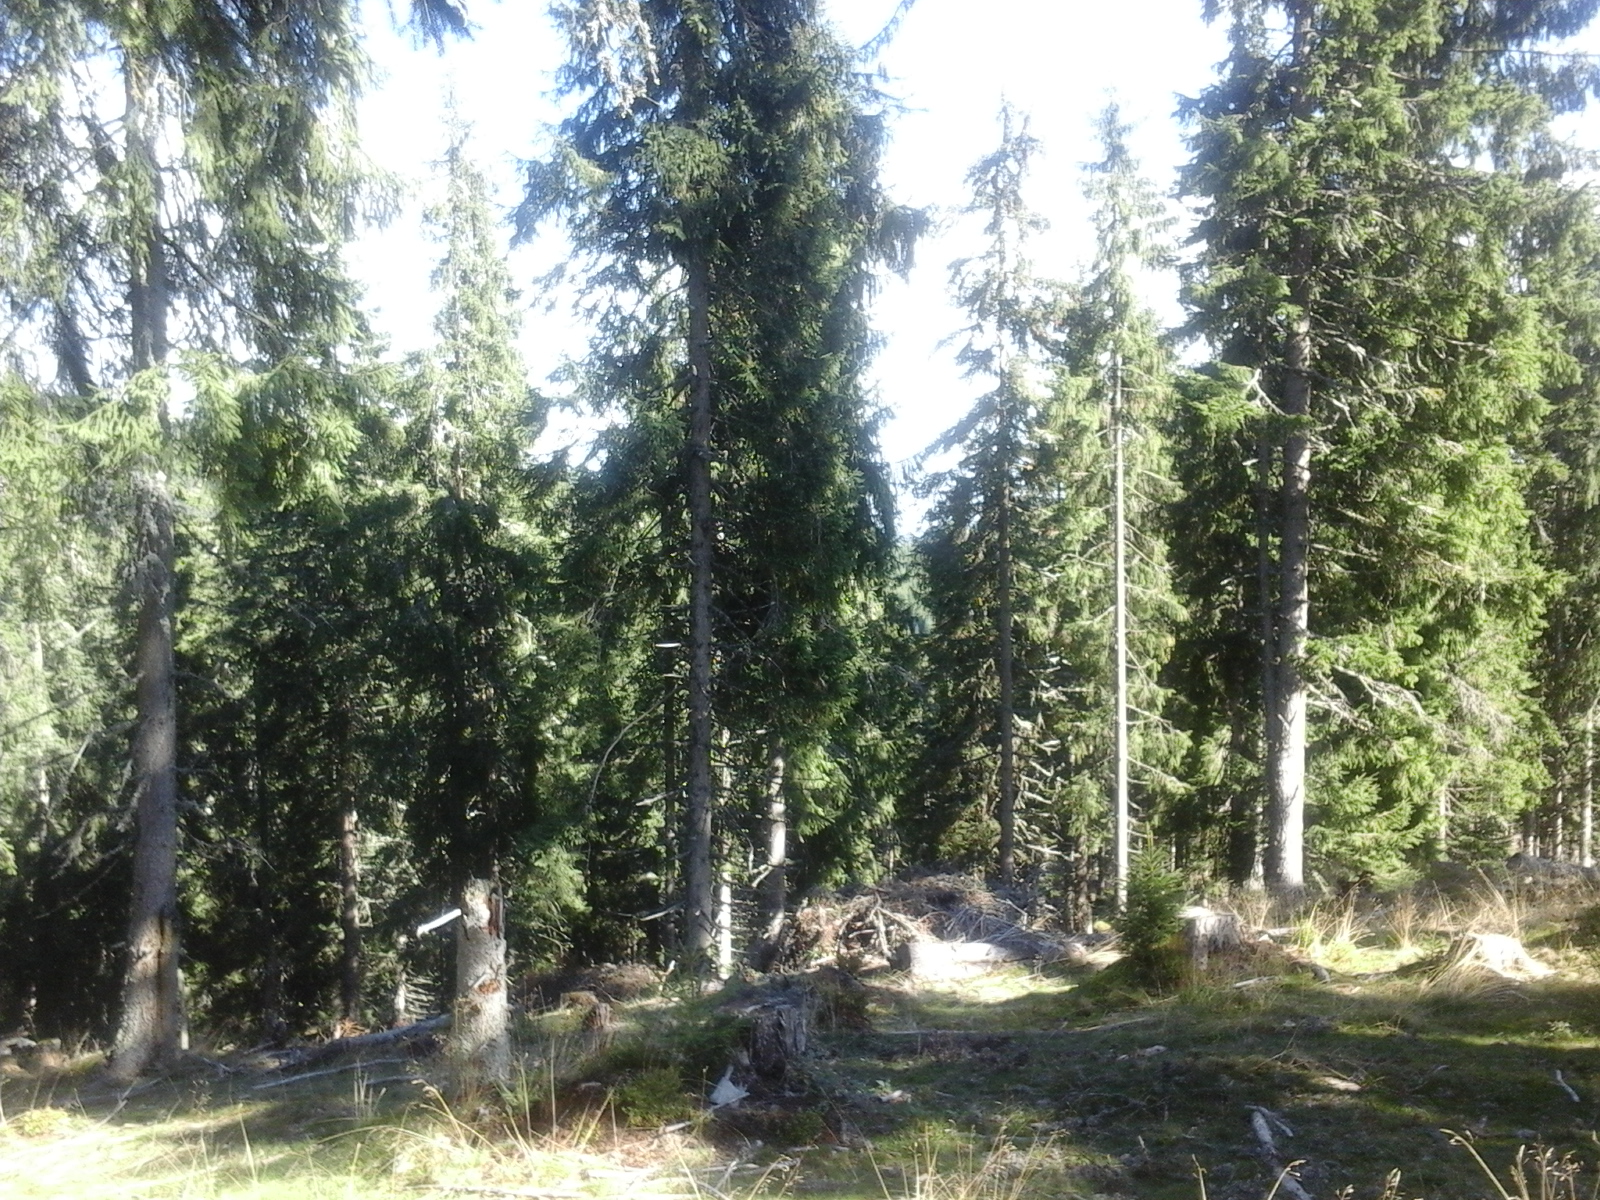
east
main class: Woodland
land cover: Spruce dominated coniferous woodland
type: alpine coniferous forest
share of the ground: > 75 %
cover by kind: coniferous forest trees 100 %
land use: Forestry
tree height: > 5 m
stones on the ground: 25 - 50 %
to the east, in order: Spruce dominated coniferous woodland; Tracks; Spruce dominated coniferous woodland; Rivers and streams; Spruce dominated coniferous woodland
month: October
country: RO
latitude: 46.5407
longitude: 22.9818
